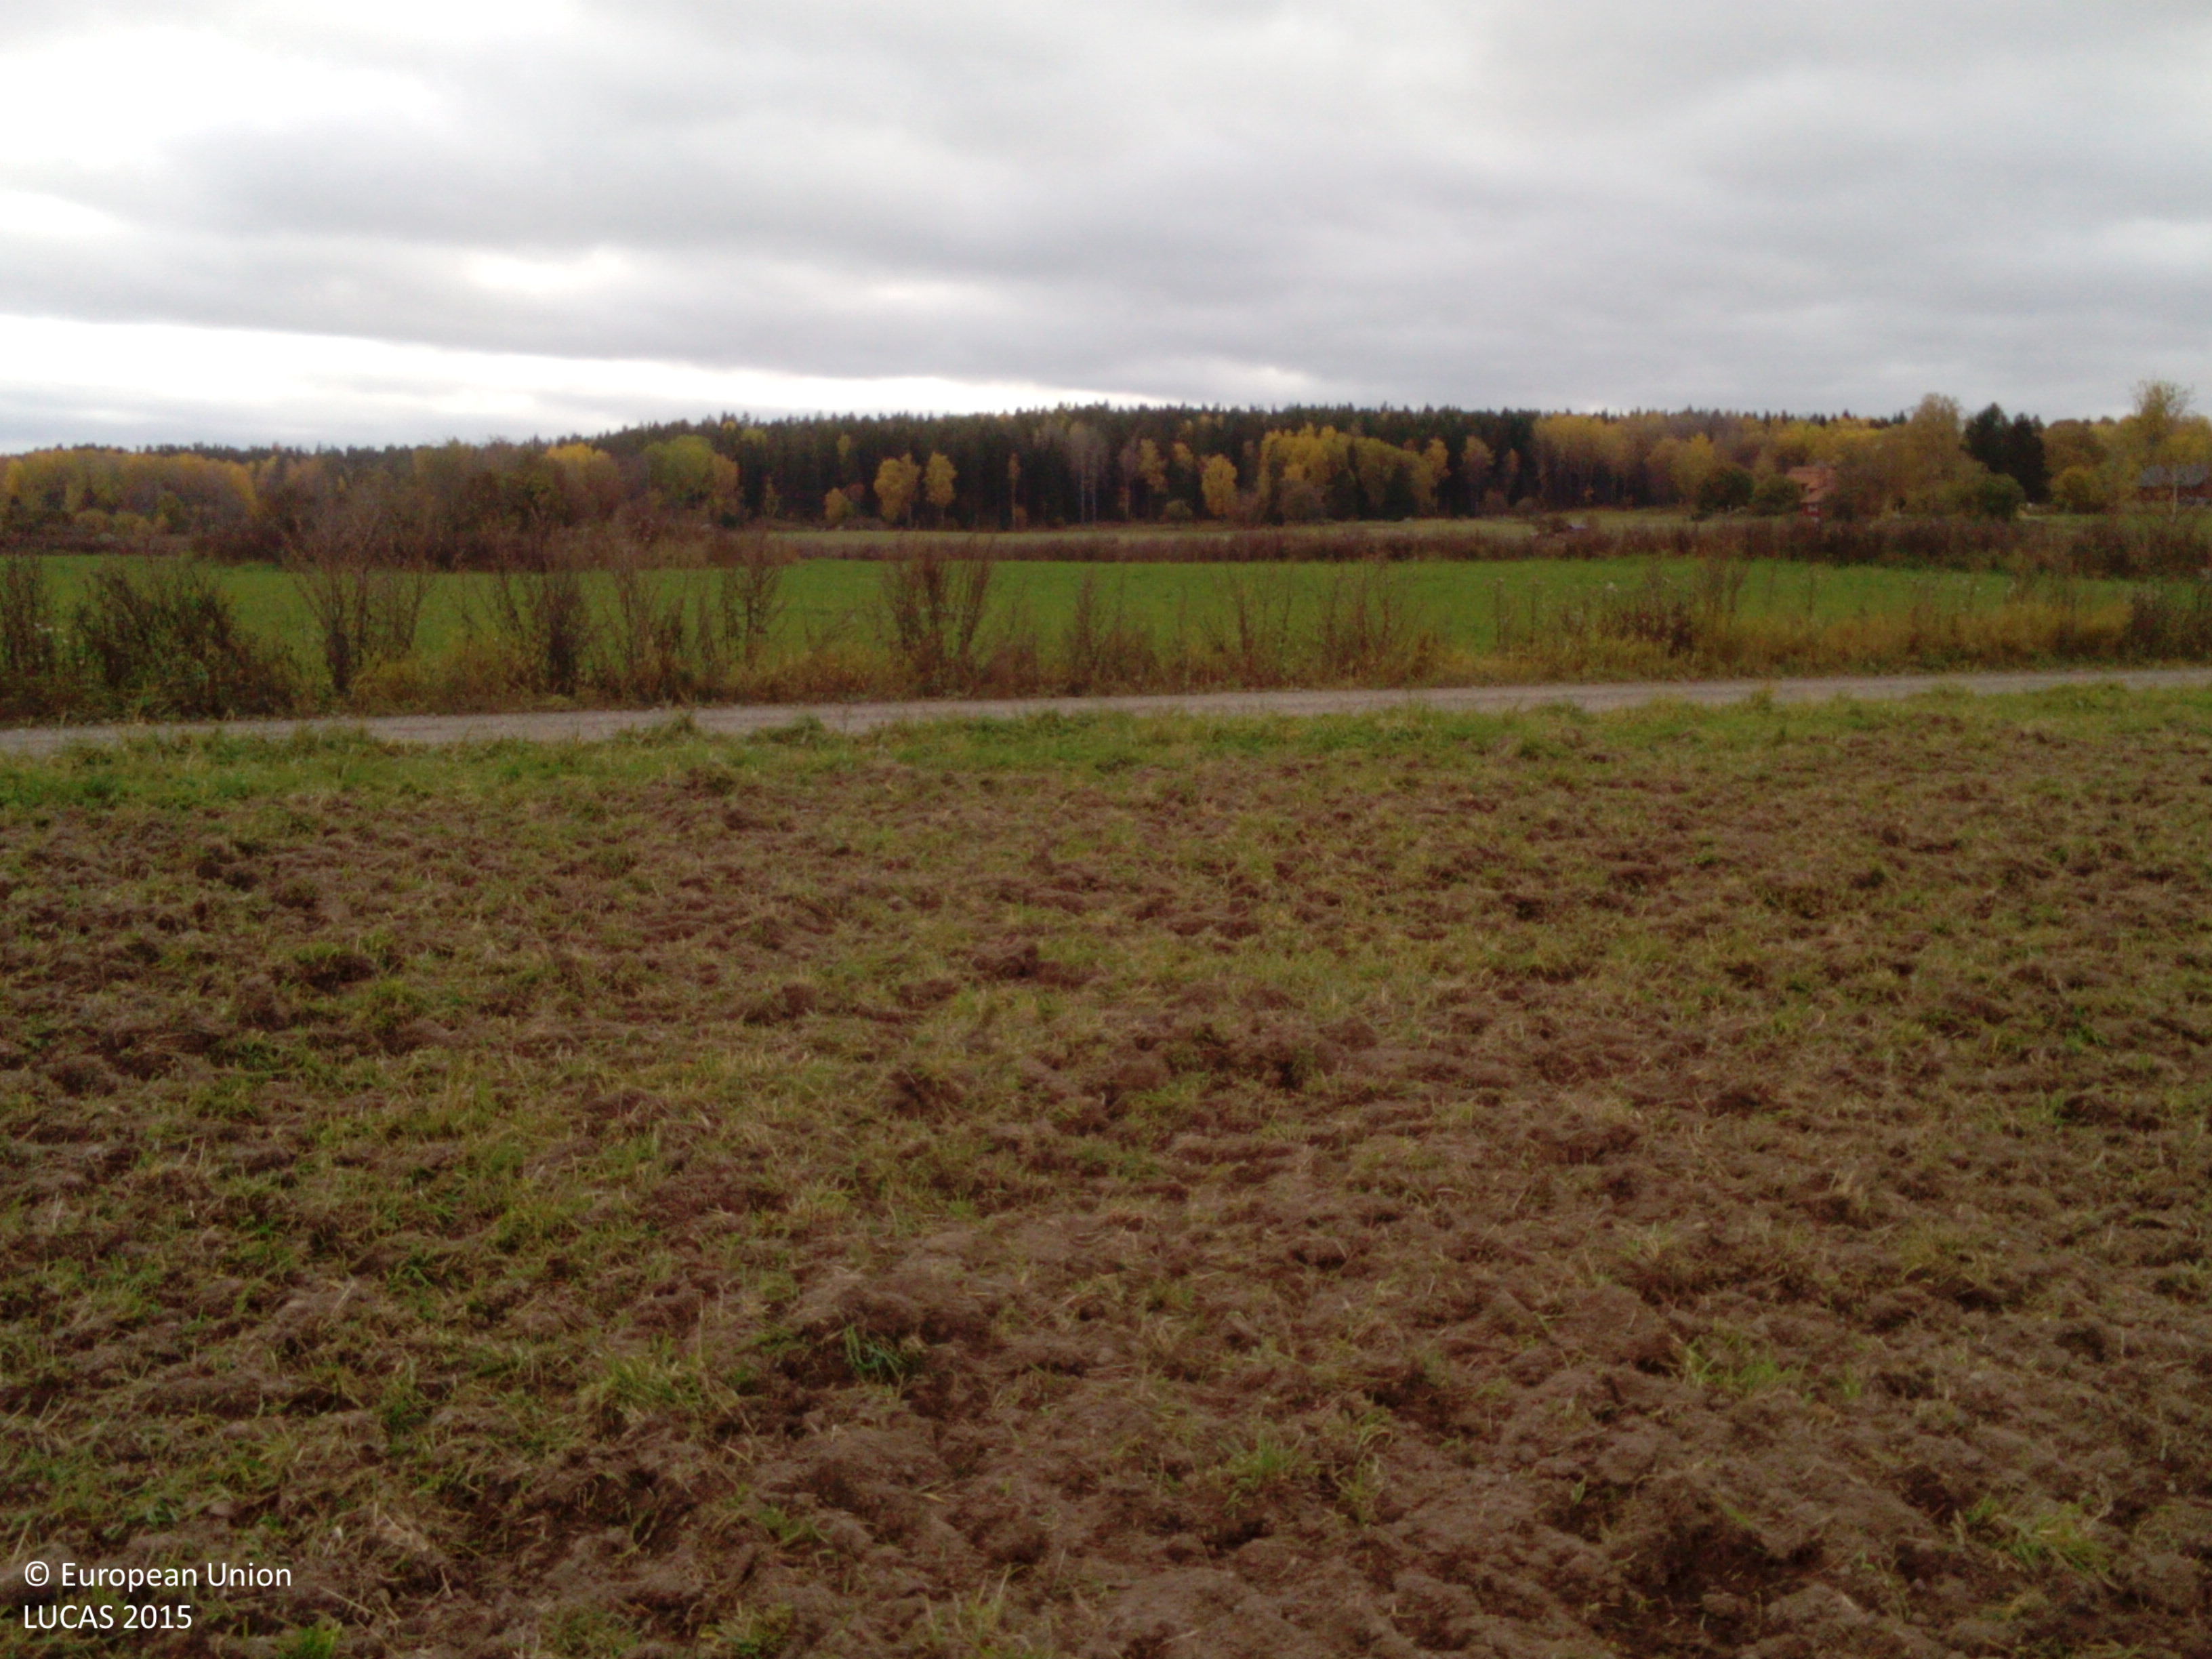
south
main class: Grassland
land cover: Grassland without tree/shrub cover
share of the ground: < 10 %
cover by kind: unconsolidated bare surface 80 %, herbaceous plants 10 %, consolidated bare surface 10 %
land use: Agriculture (excluding fallow land and kitchen gardens)
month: October
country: SE
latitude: 59.2311
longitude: 16.2143
